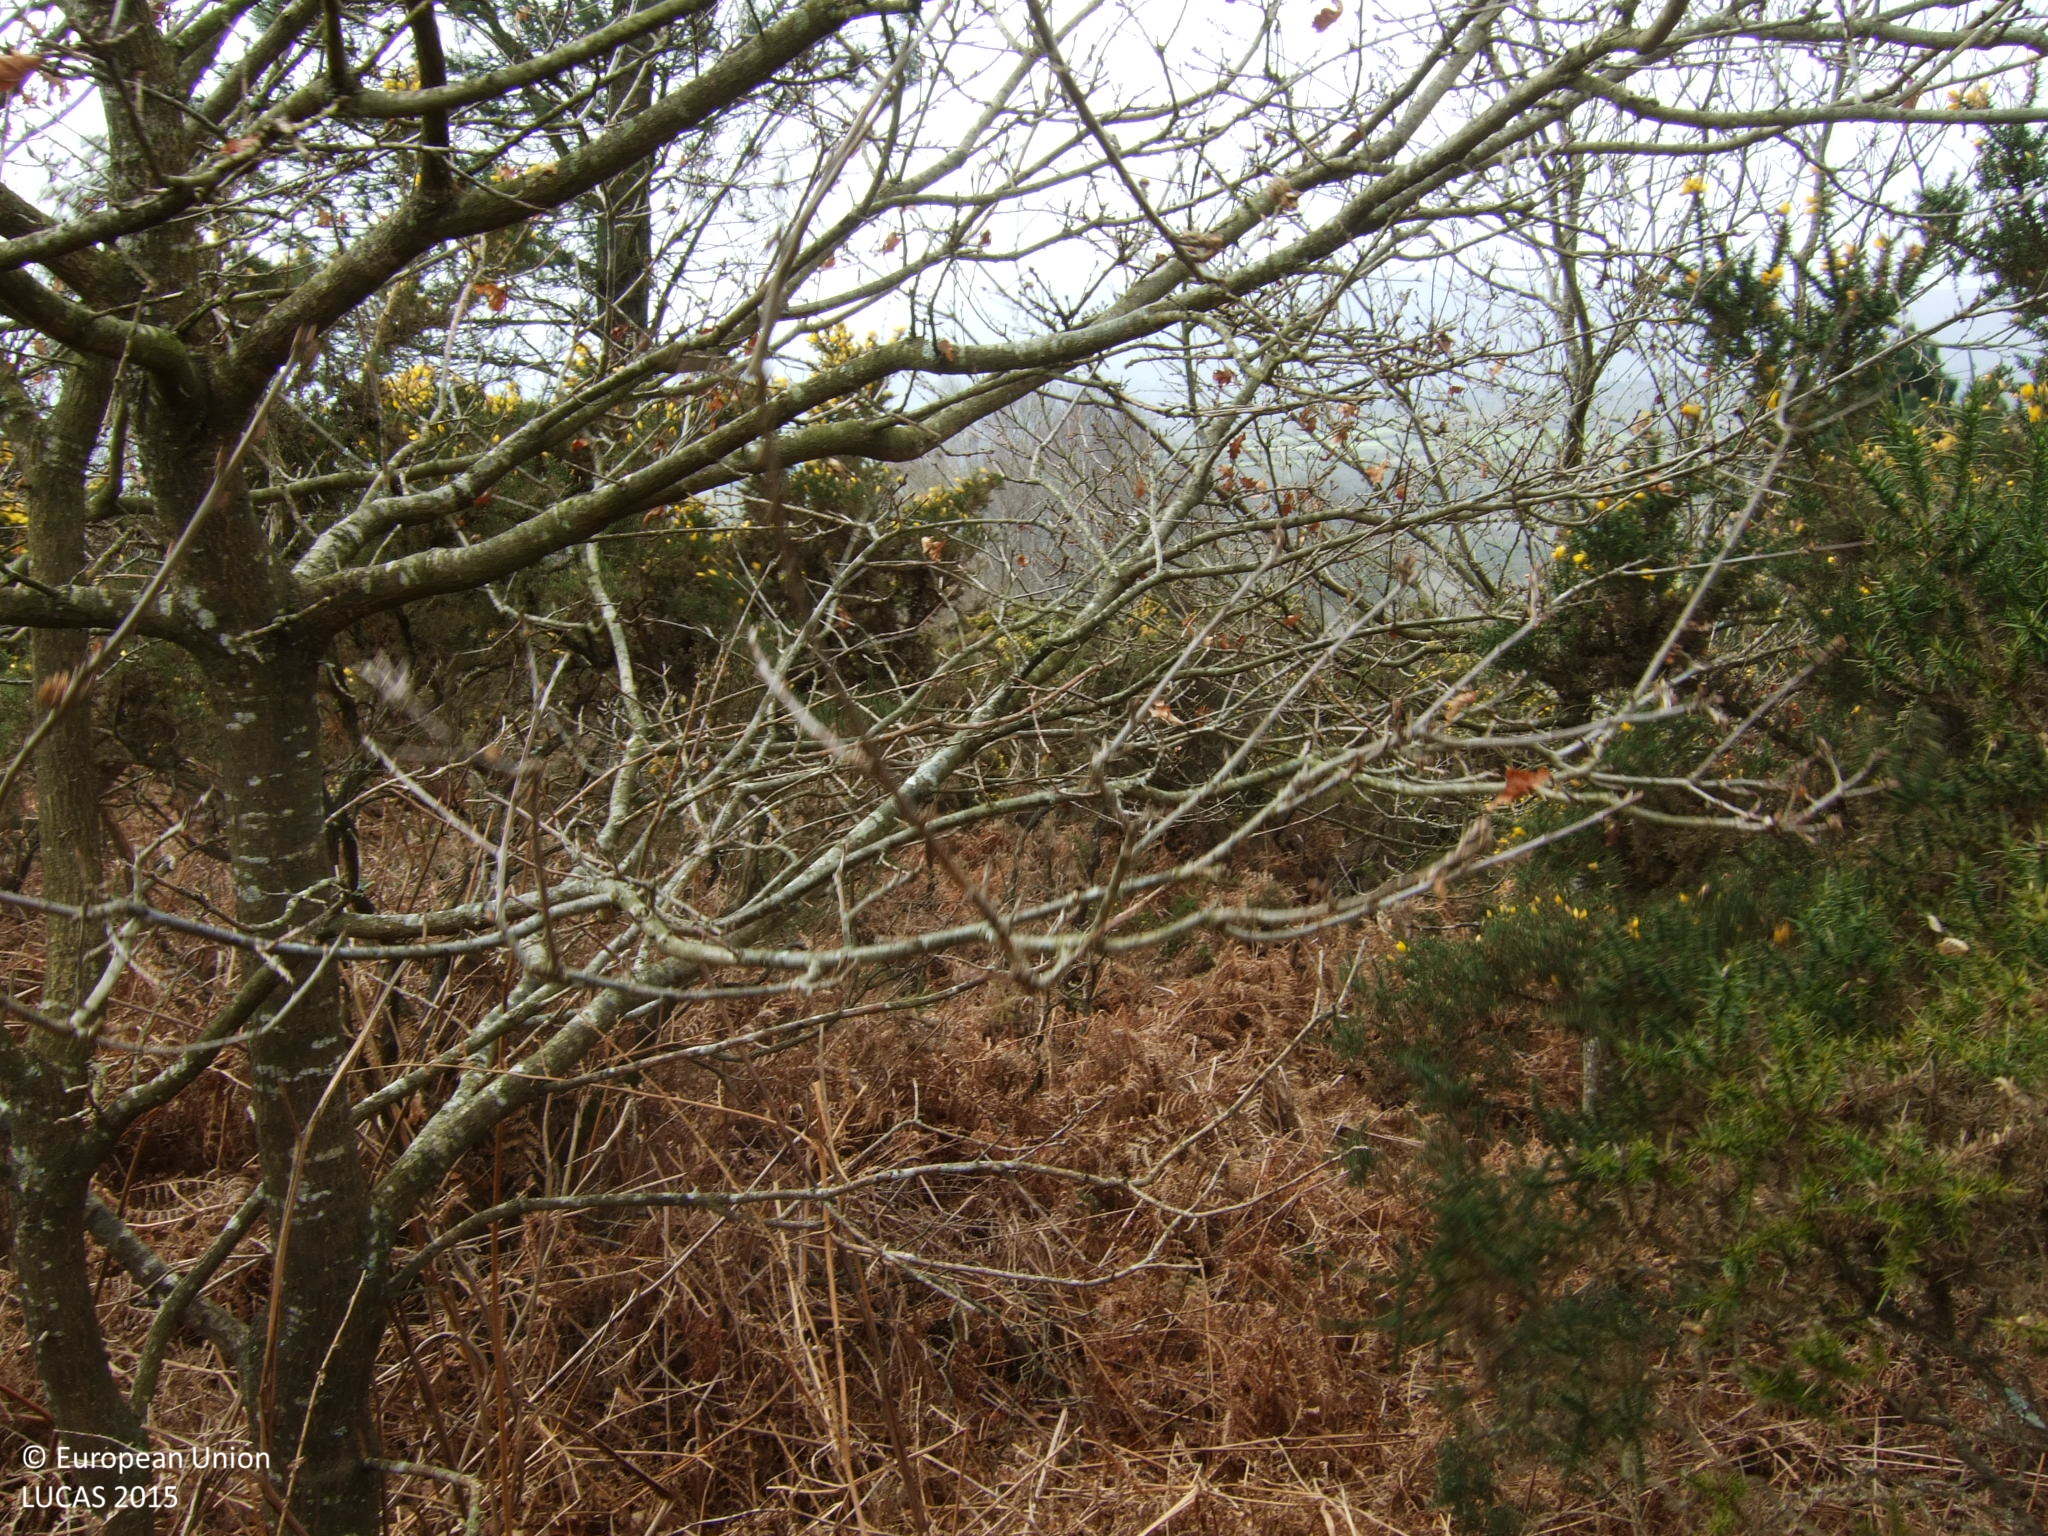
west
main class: Woodland
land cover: Broadleaved woodland
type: acidophilous oak and oak-birch forest
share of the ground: > 75 %
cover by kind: broadleaved forest trees 80 %, shrubs 20 %
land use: Semi-natural and natural areas not in use
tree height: > 5 m
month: March
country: ES
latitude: 42.9323
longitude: -7.8645
